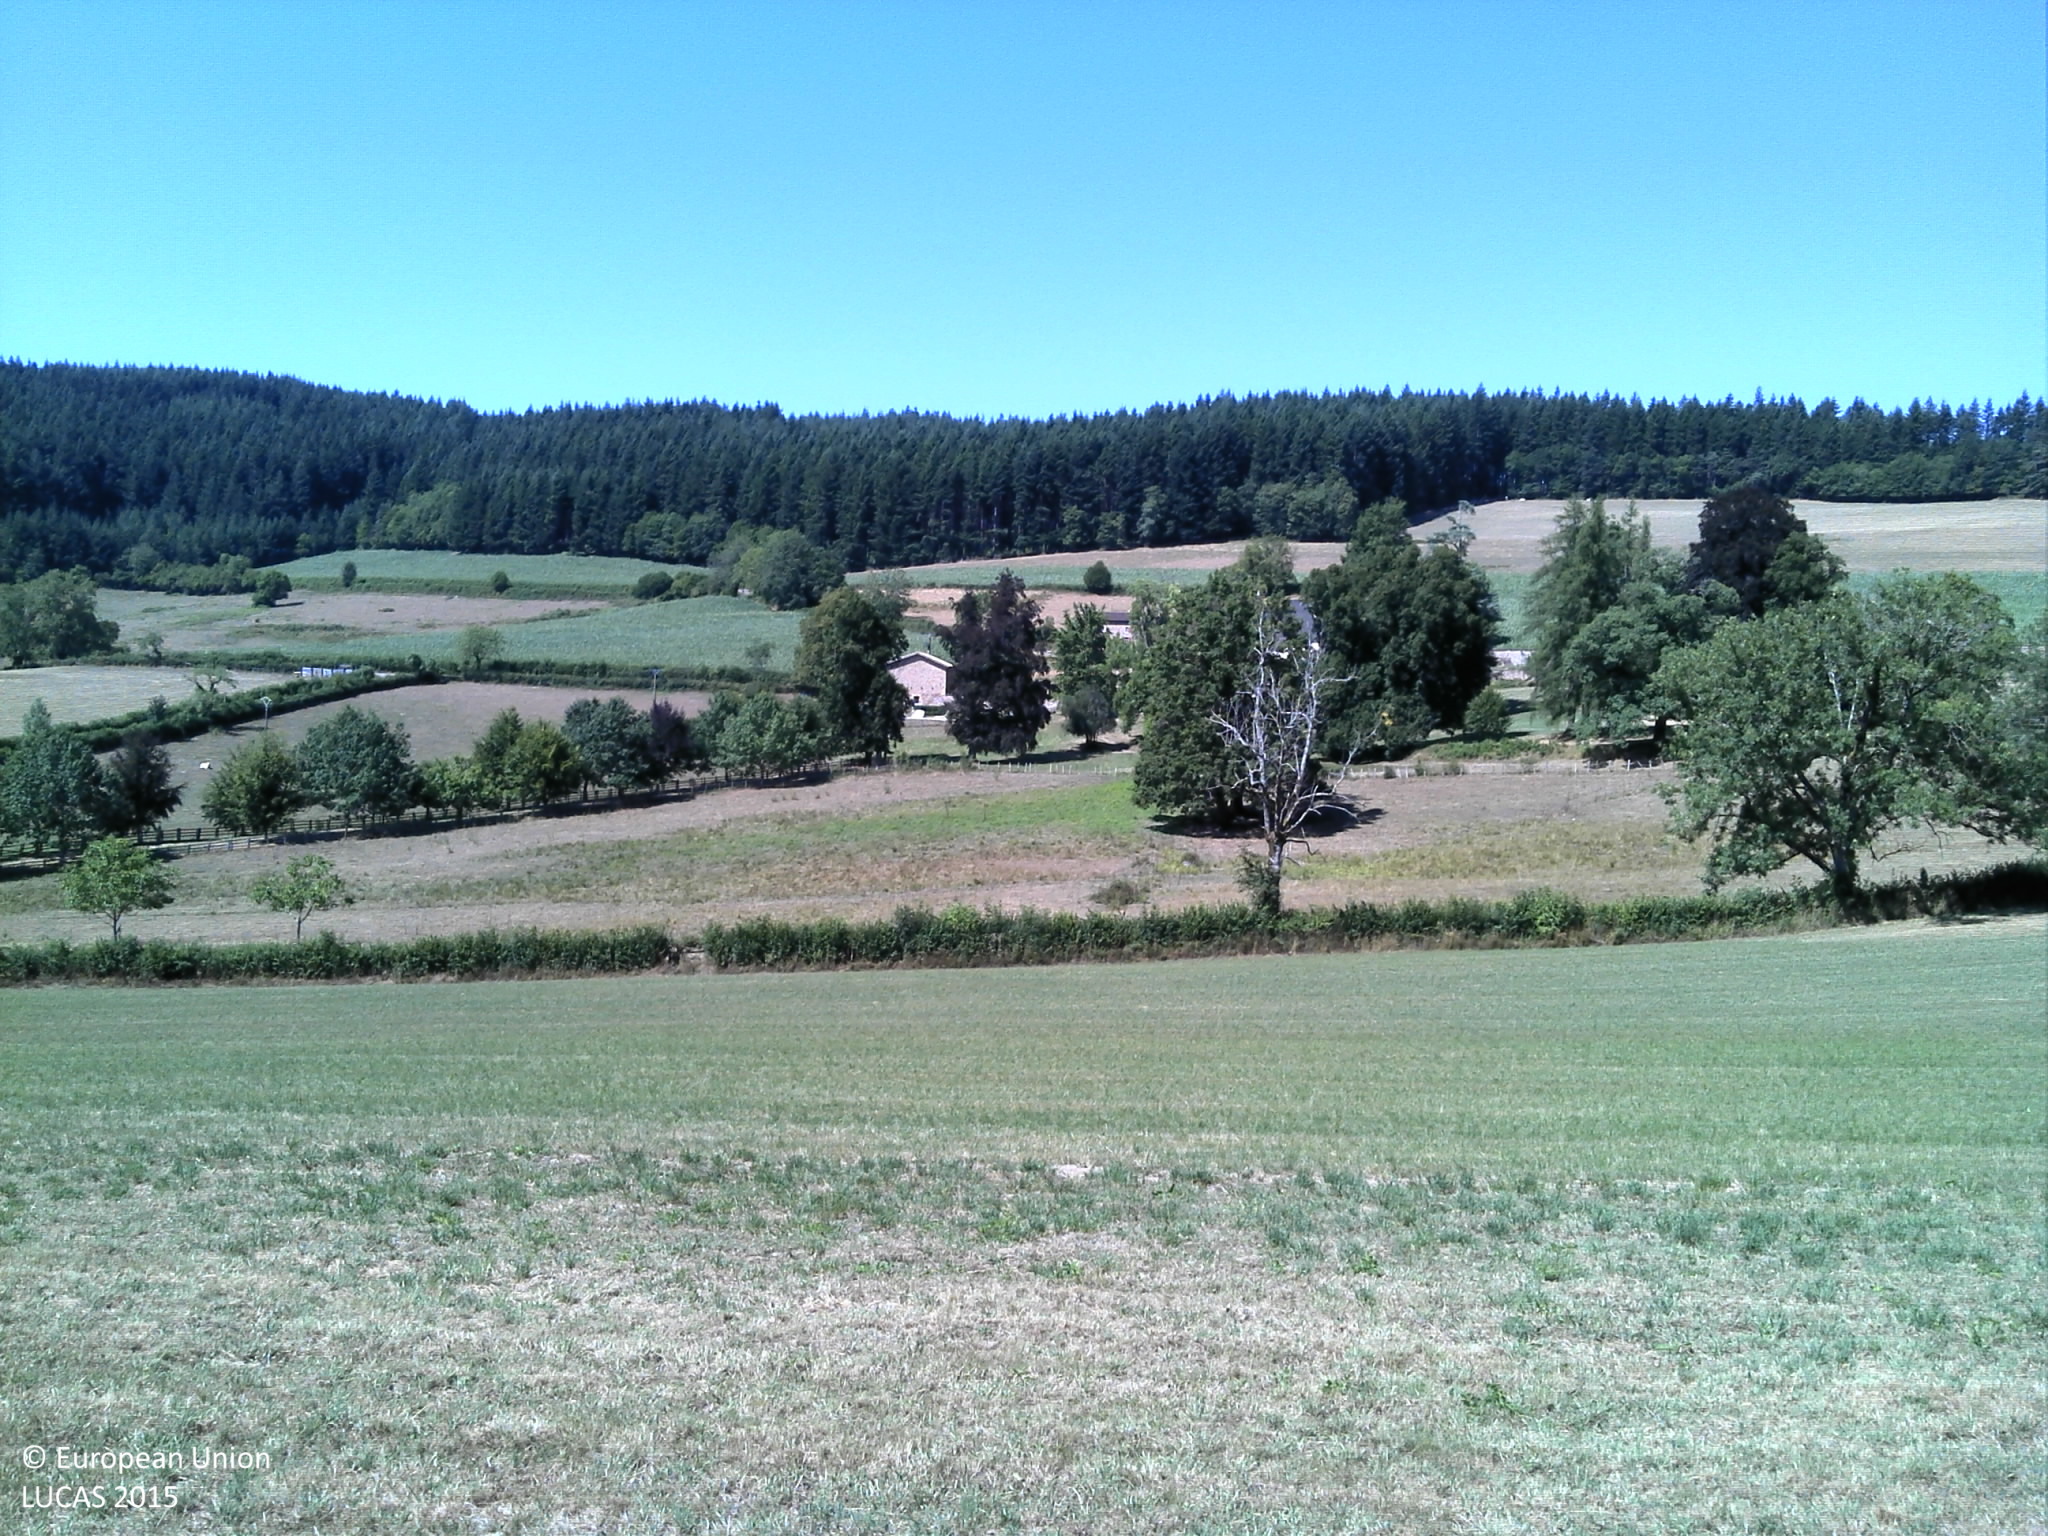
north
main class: Grassland
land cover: Grassland without tree/shrub cover
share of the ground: > 75 %
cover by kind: herbaceous plants 100 %
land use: Agriculture (excluding fallow land and kitchen gardens)
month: August
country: FR
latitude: 46.2054
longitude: 4.4159
